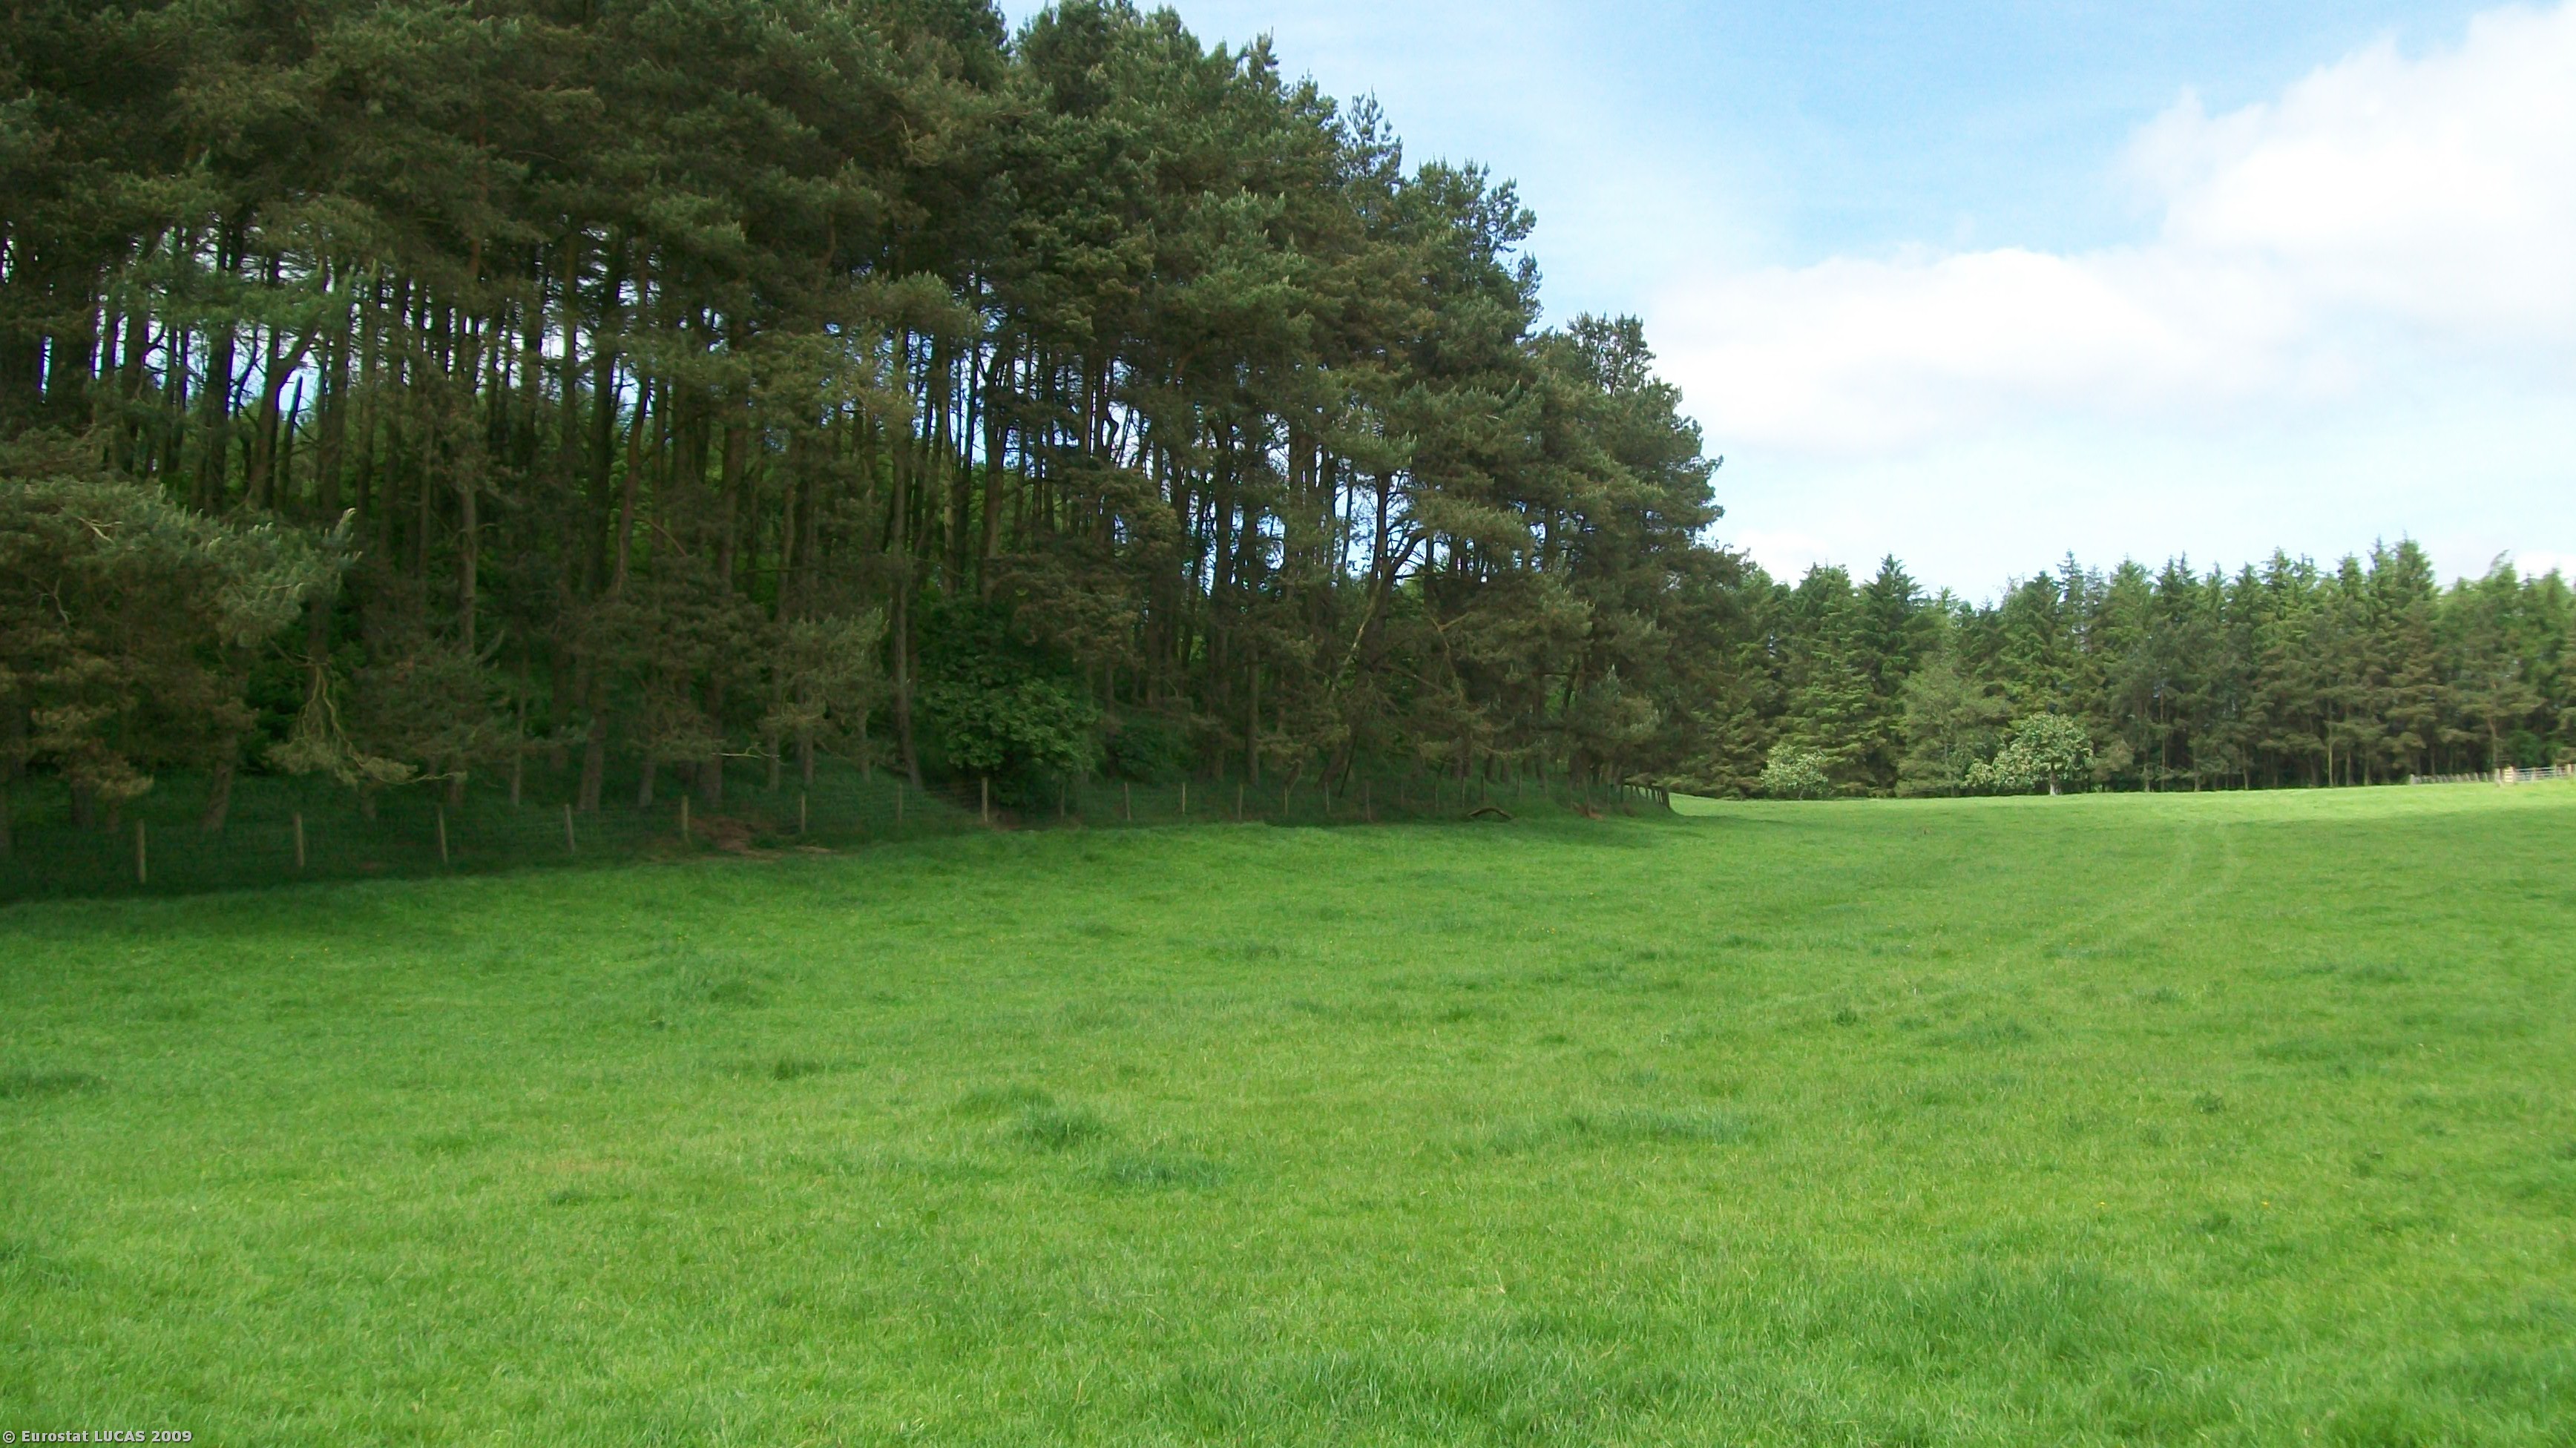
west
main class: Grassland
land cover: Grassland without tree/shrub cover
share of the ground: > 75 %
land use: Agriculture (excluding fallow land and kitchen gardens)
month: June
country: GB
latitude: 55.6978
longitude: -3.5882
